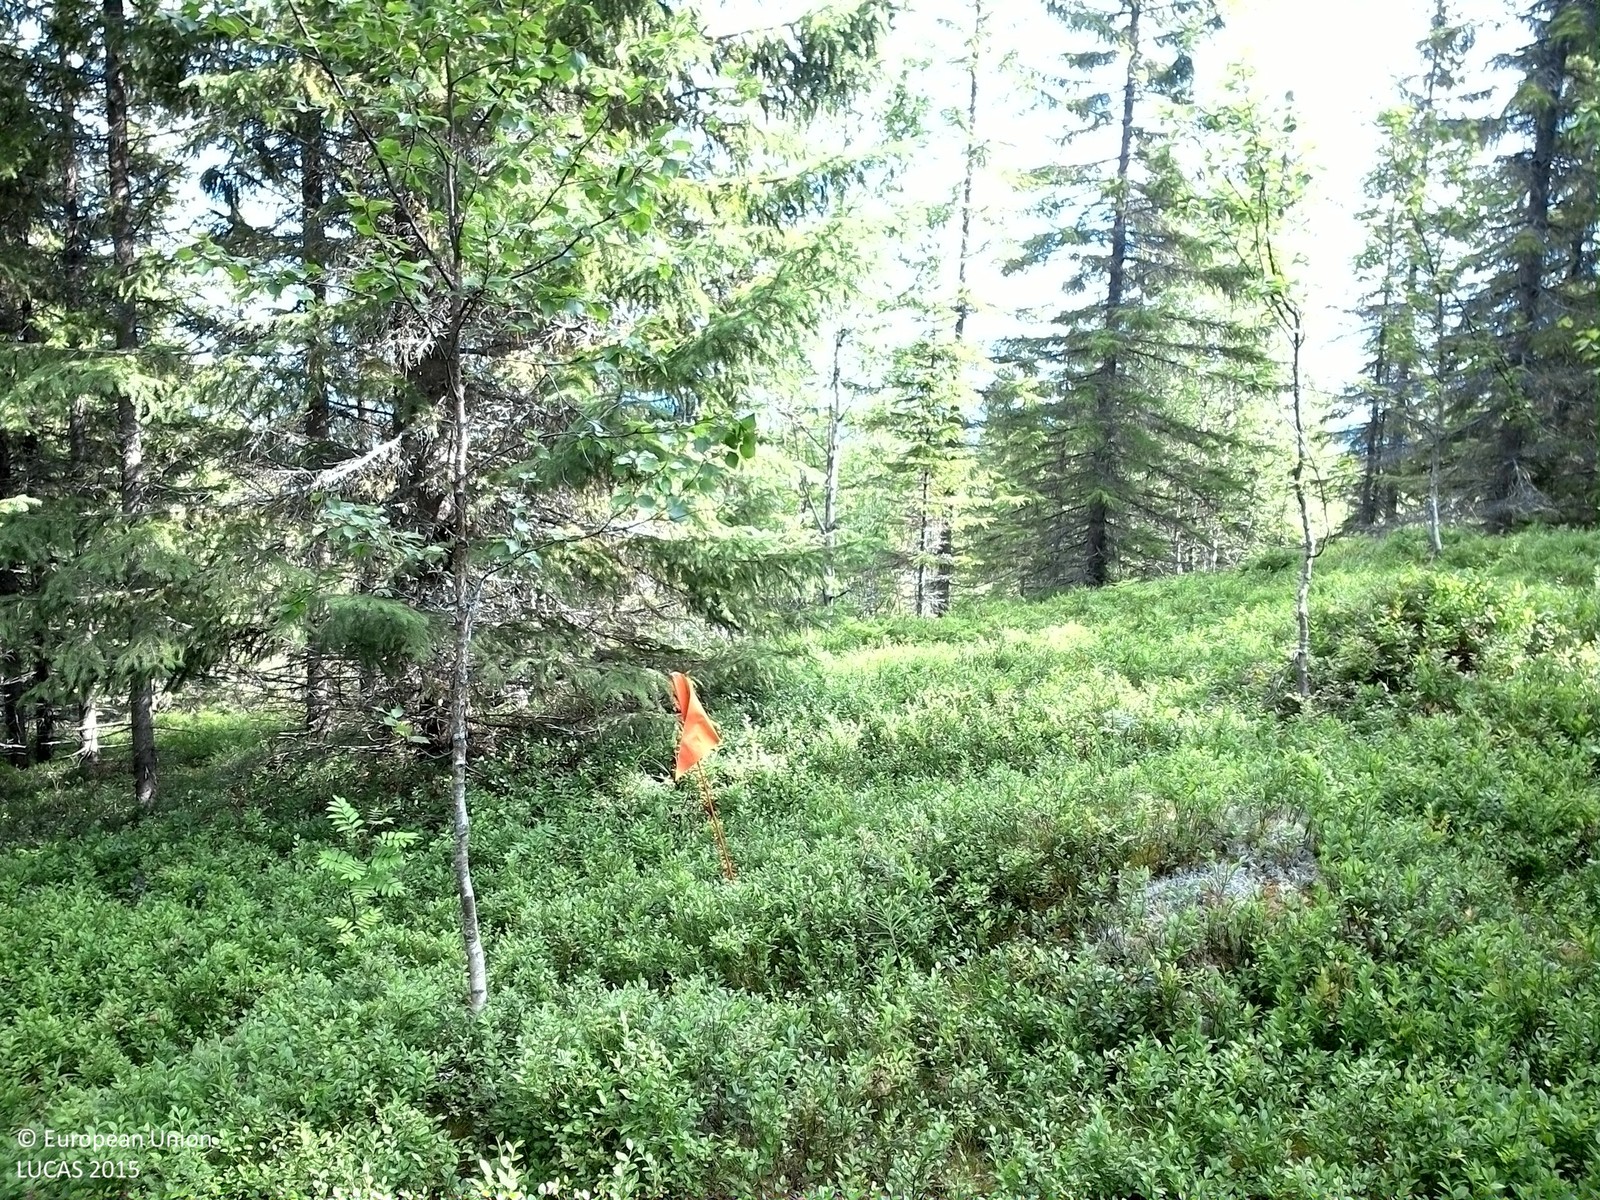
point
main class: Woodland
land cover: Spruce dominated coniferous woodland
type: boreal forest
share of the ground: 50 - 75 %
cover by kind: coniferous forest trees 55 %, shrubs 35 %, broadleaved forest trees 10 %
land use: Forestry
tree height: > 5 m
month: August
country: SE
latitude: 63.6466
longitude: 18.4349
